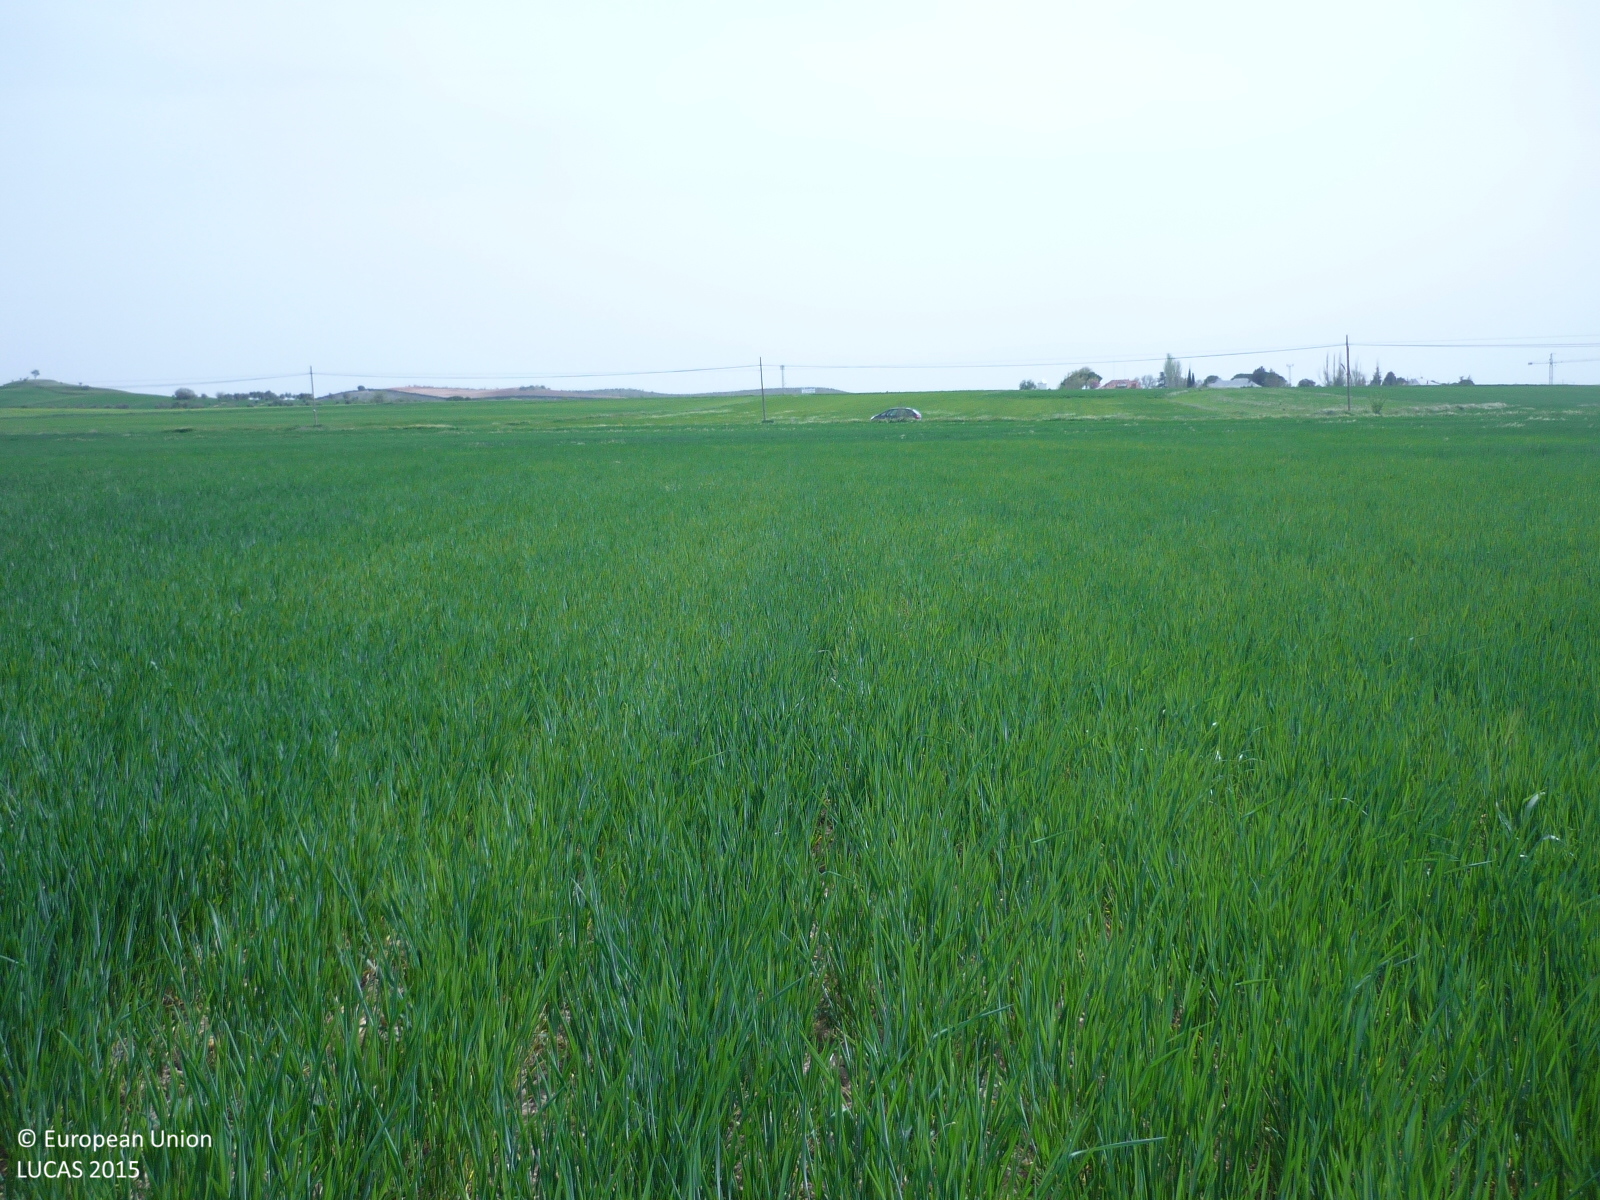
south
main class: Cropland
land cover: Common wheat
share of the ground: > 75 %
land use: Agriculture (excluding fallow land and kitchen gardens)
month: April
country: ES
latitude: 40.6082
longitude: -3.5228
